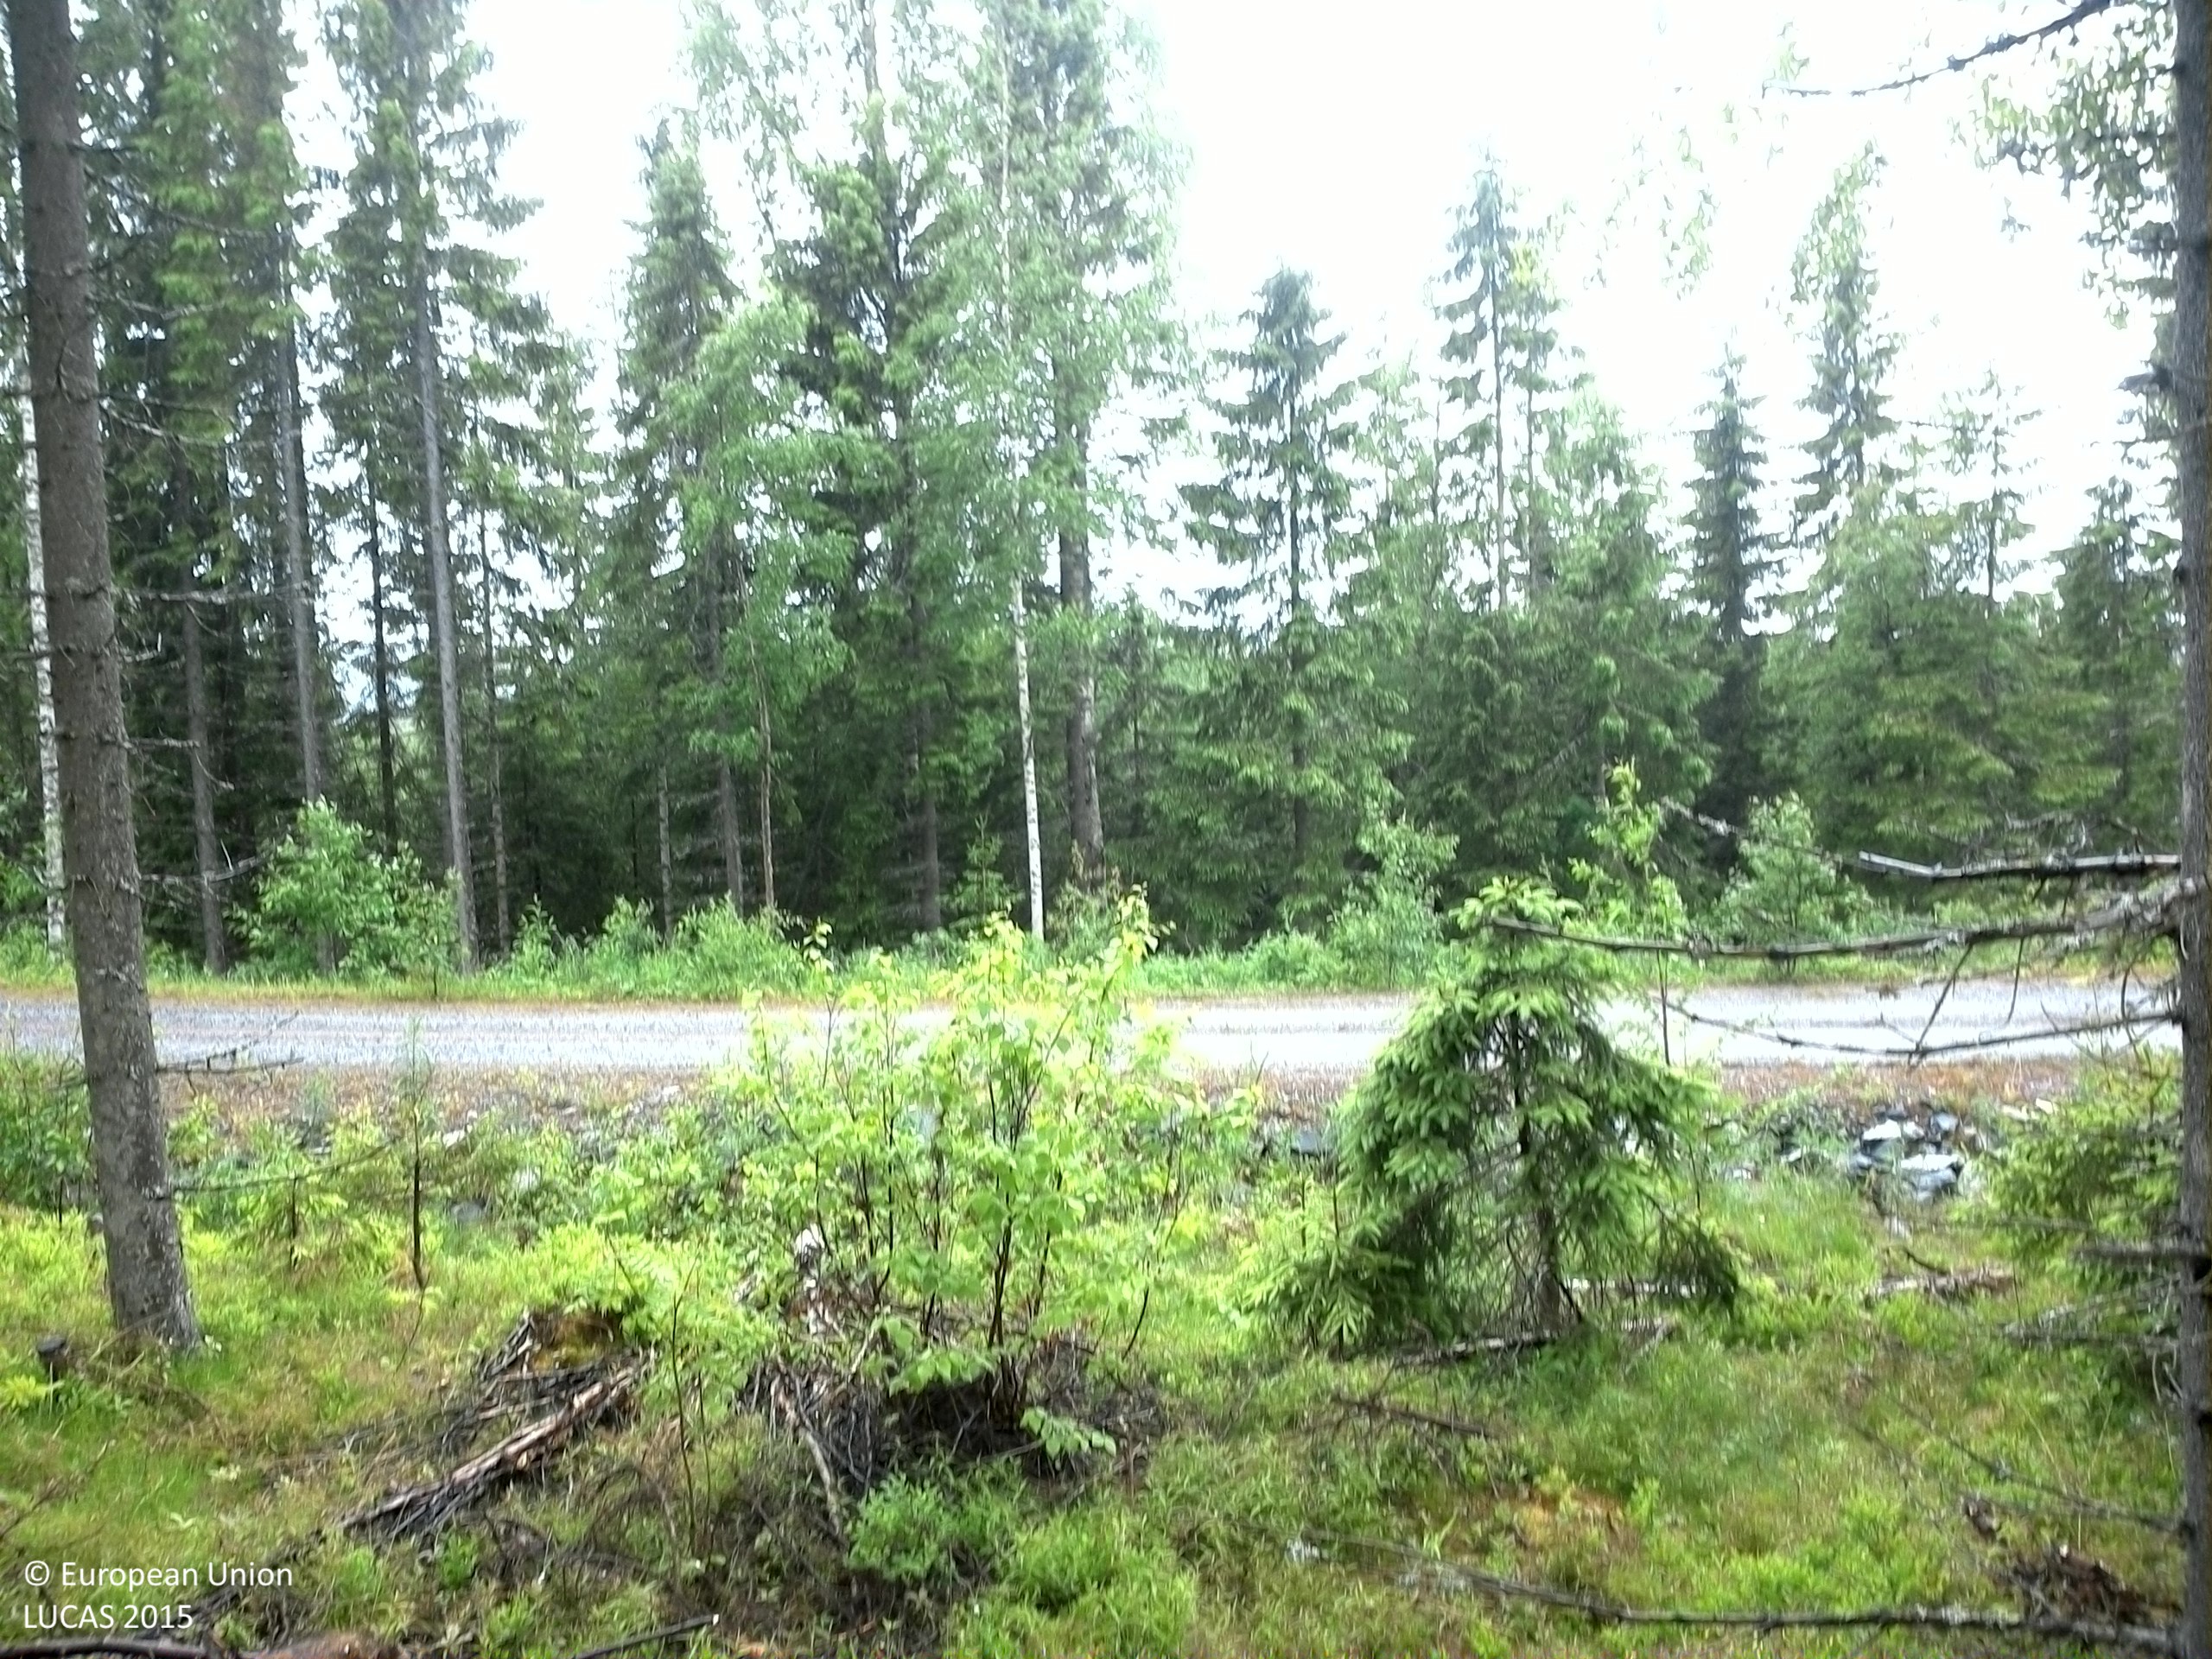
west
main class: Woodland
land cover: Spruce dominated mixed woodland
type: boreal forest
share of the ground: > 75 %
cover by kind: coniferous forest trees 60 %, broadleaved forest trees 20 %, shrubs 15 %, herbaceous plants 5 %
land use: Forestry
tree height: > 5 m
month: June
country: SE
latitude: 62.7669
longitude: 17.9124
